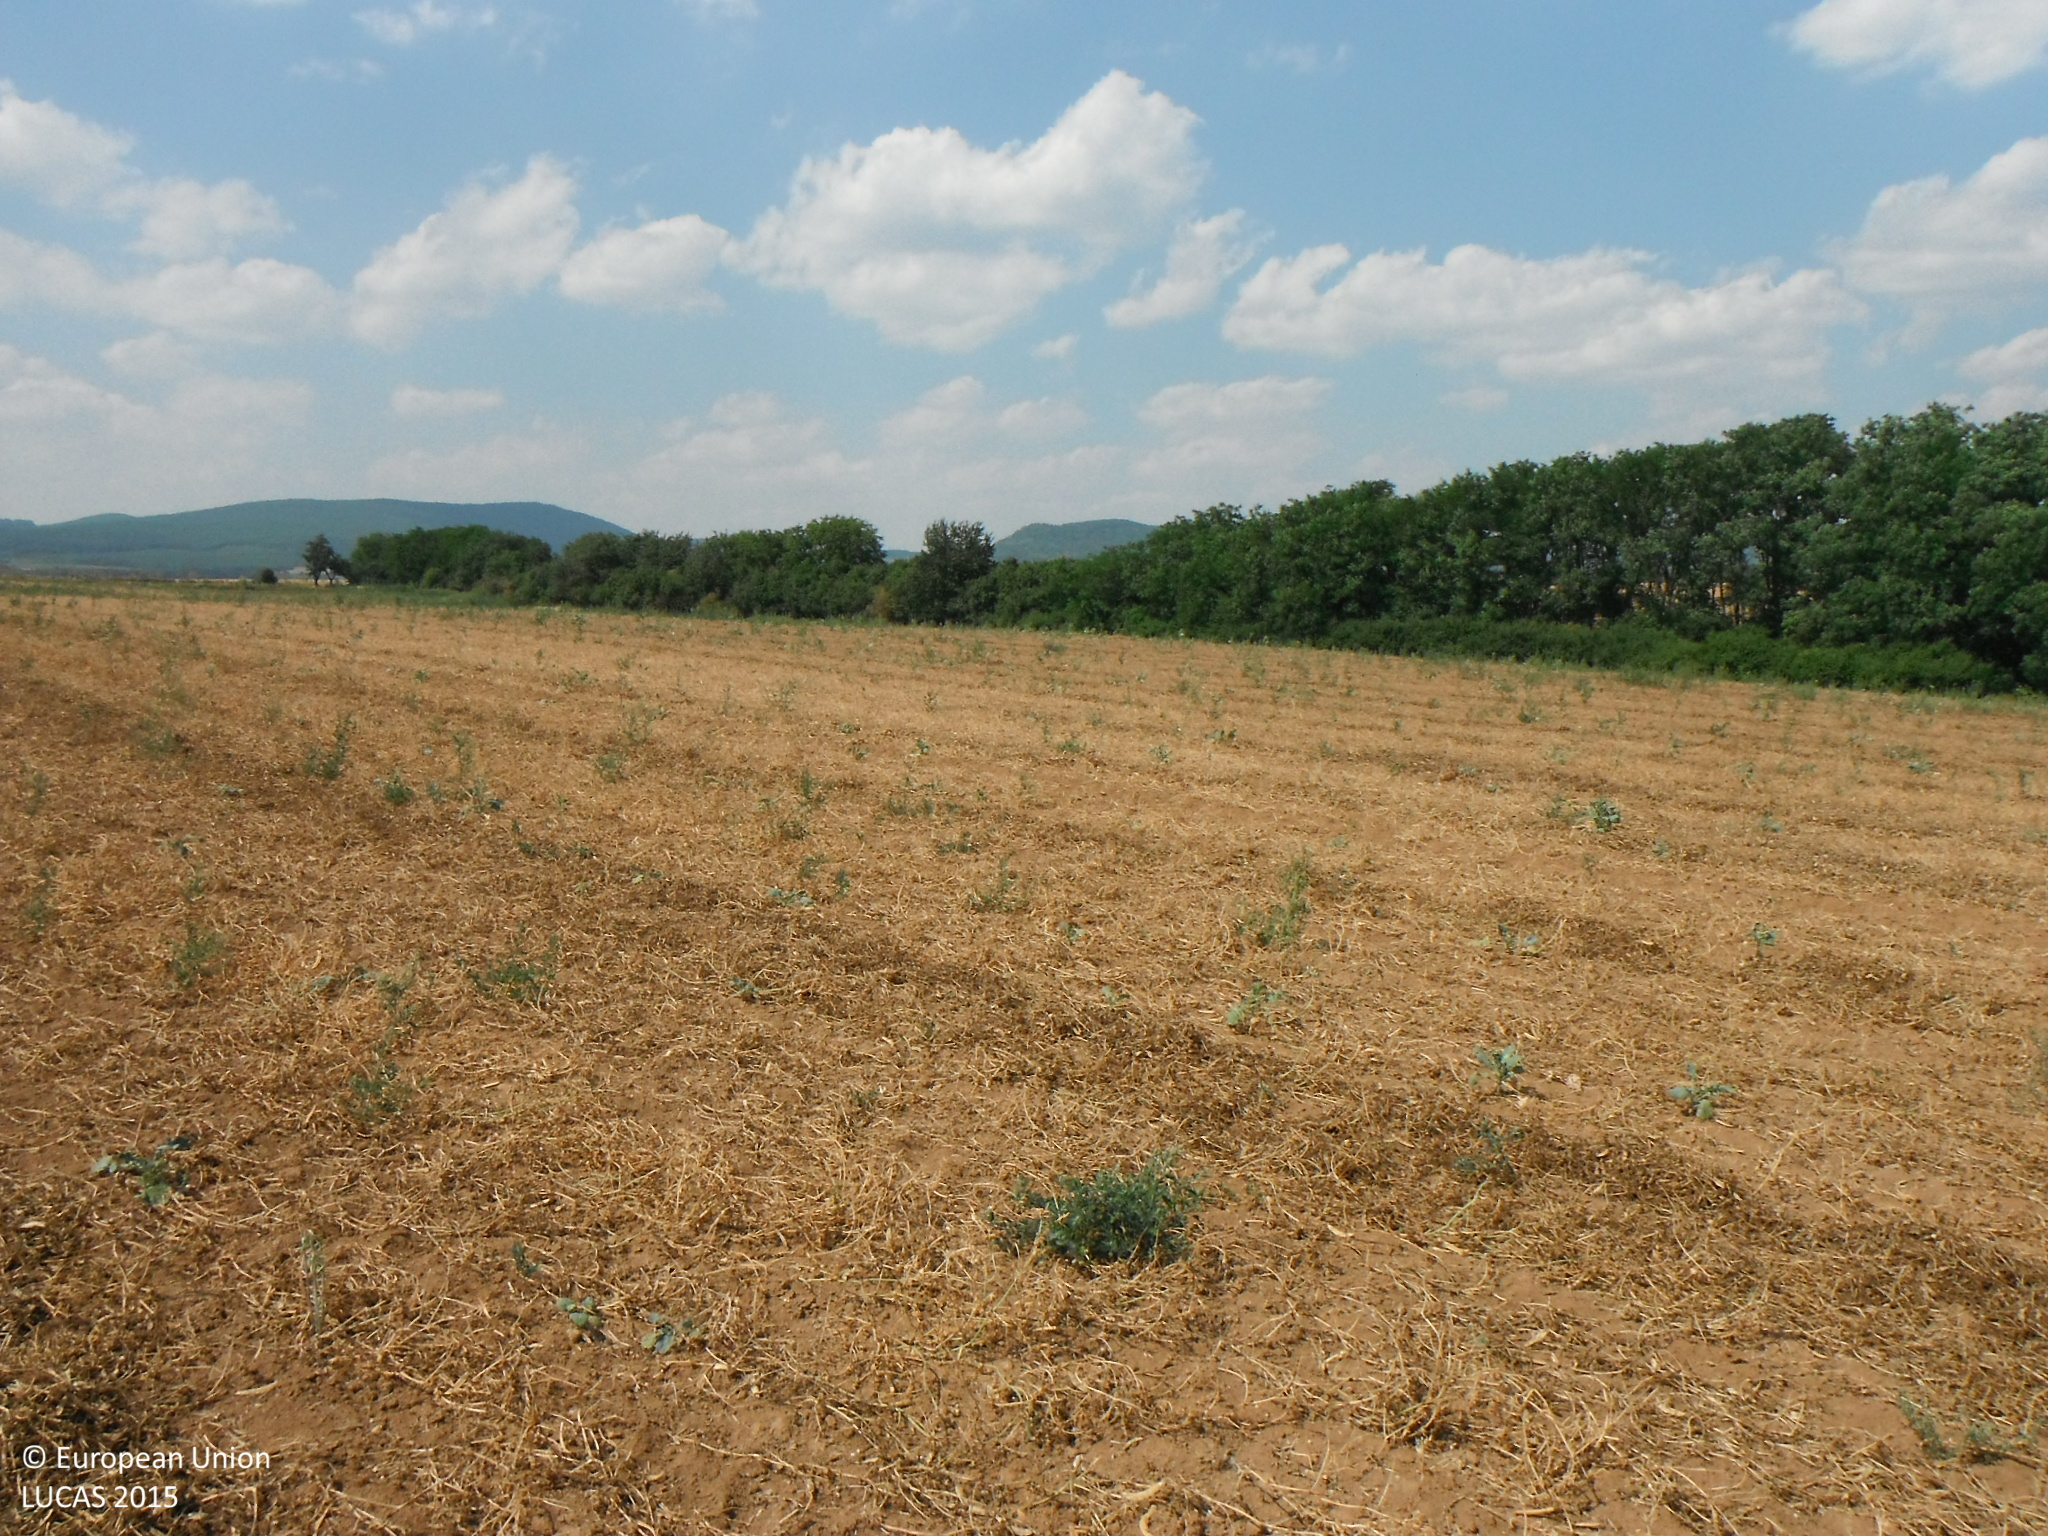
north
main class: Cropland
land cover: Dry pulses
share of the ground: > 75 %
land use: Agriculture (excluding fallow land and kitchen gardens)
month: July
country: SK
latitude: 48.0991
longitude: 19.1113
